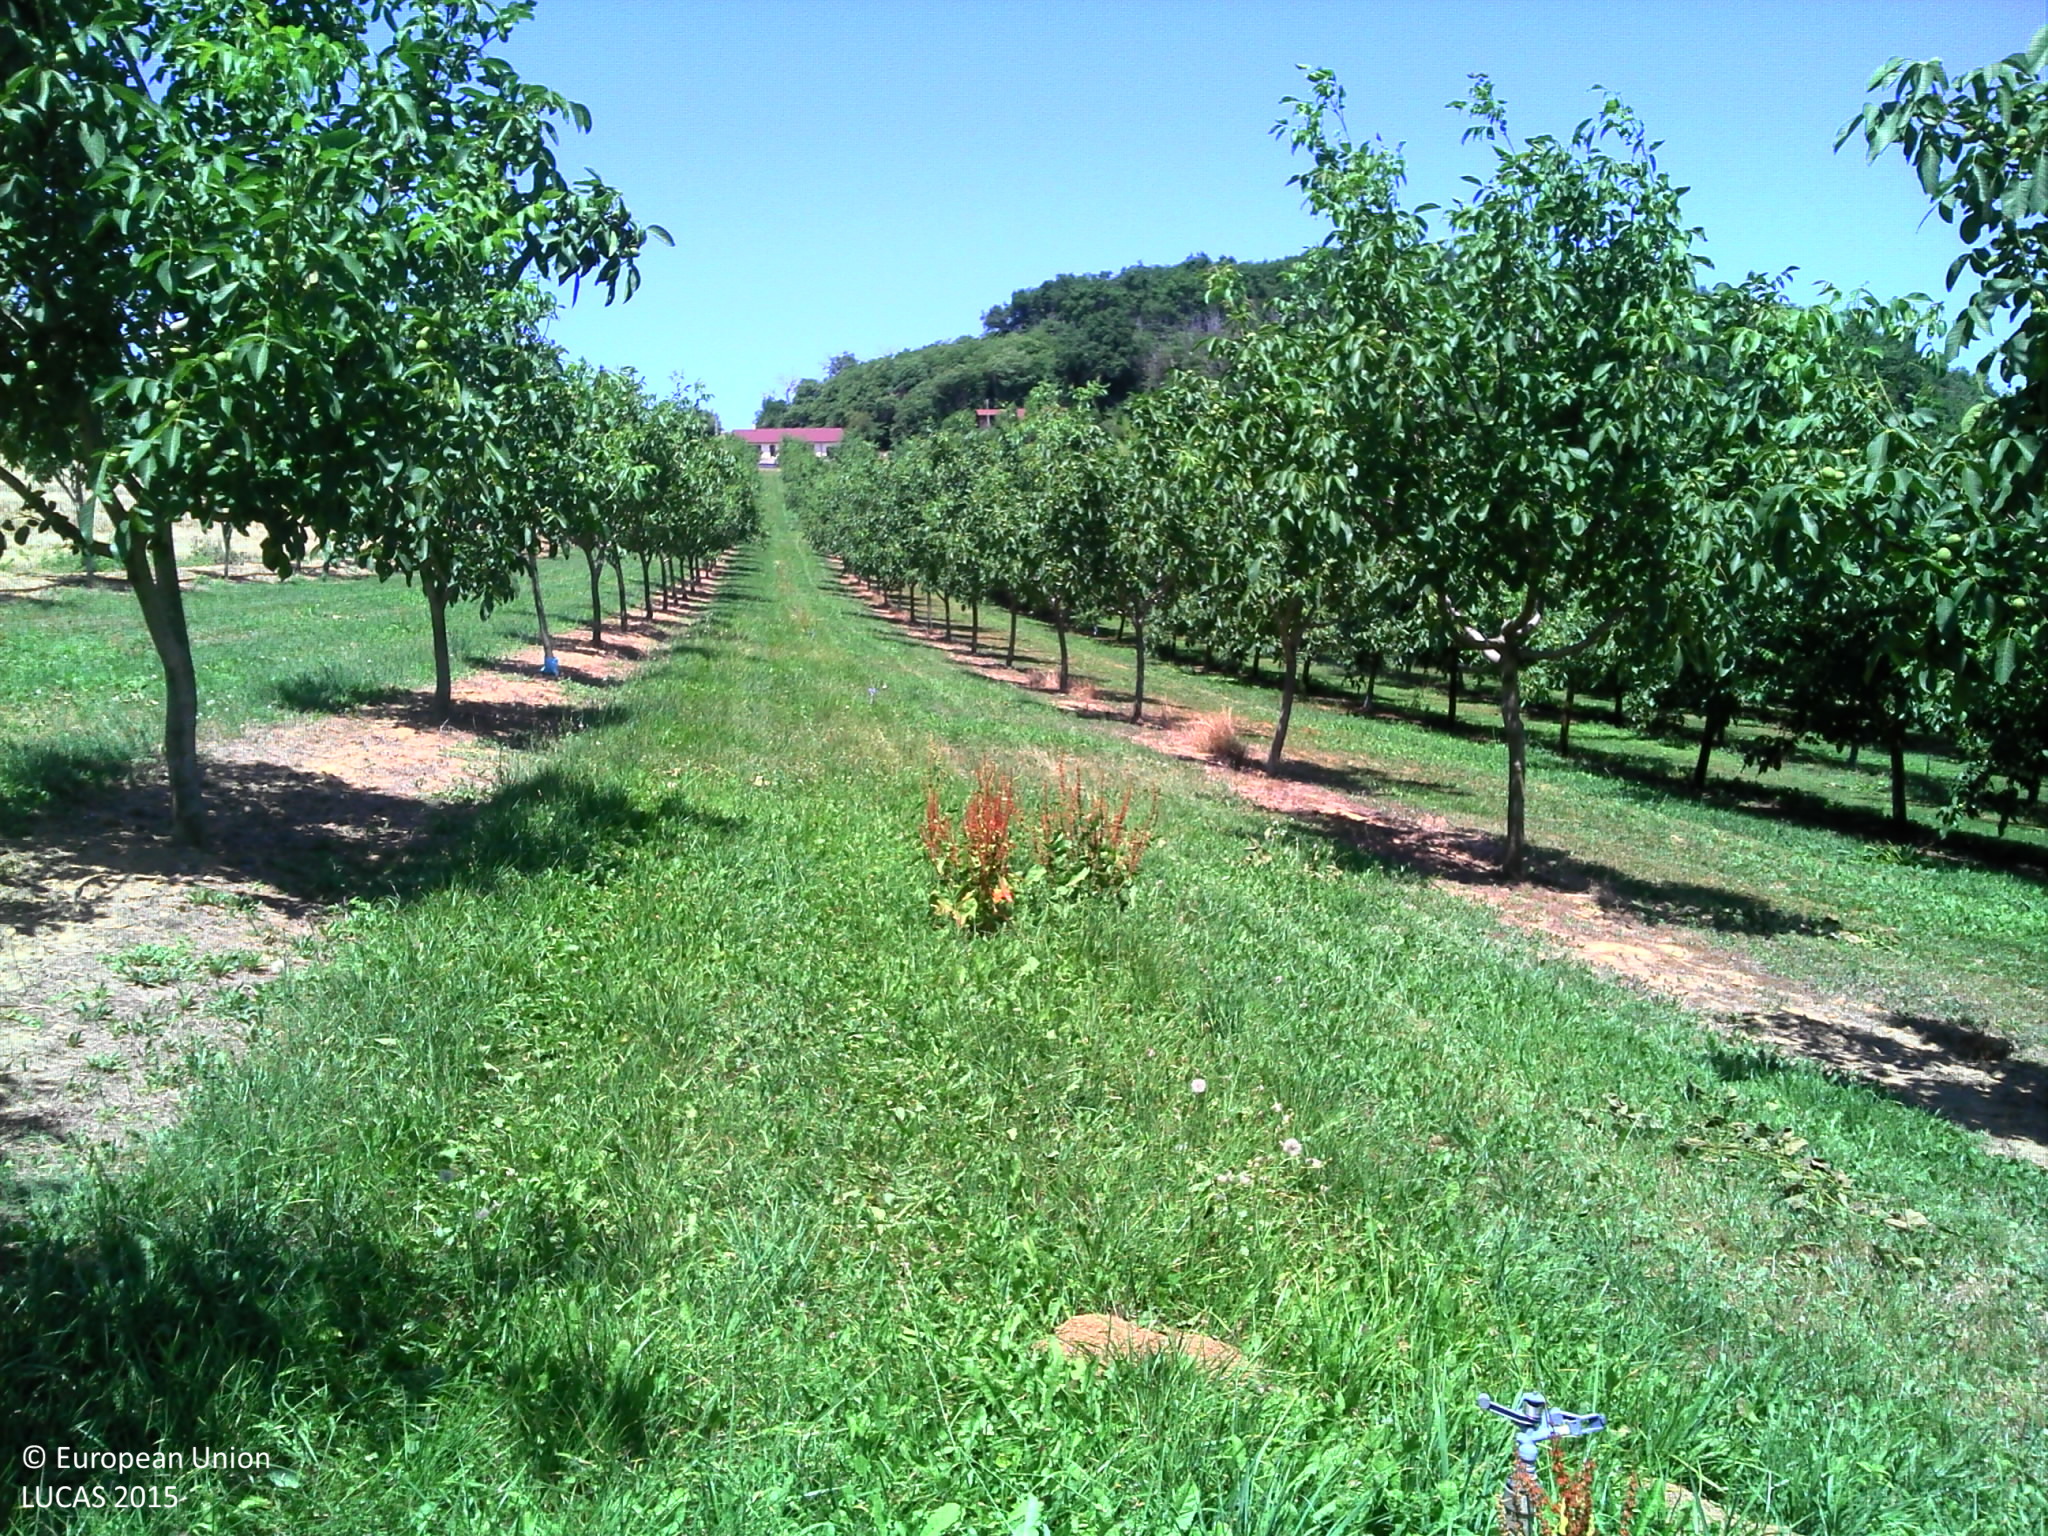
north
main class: Cropland
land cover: Nuts trees
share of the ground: 25 - 50 %
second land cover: Grassland without tree/shrub cover
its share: > 75 %
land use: Agriculture (excluding fallow land and kitchen gardens)
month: July
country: FR
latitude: 45.1430
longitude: 5.2108
